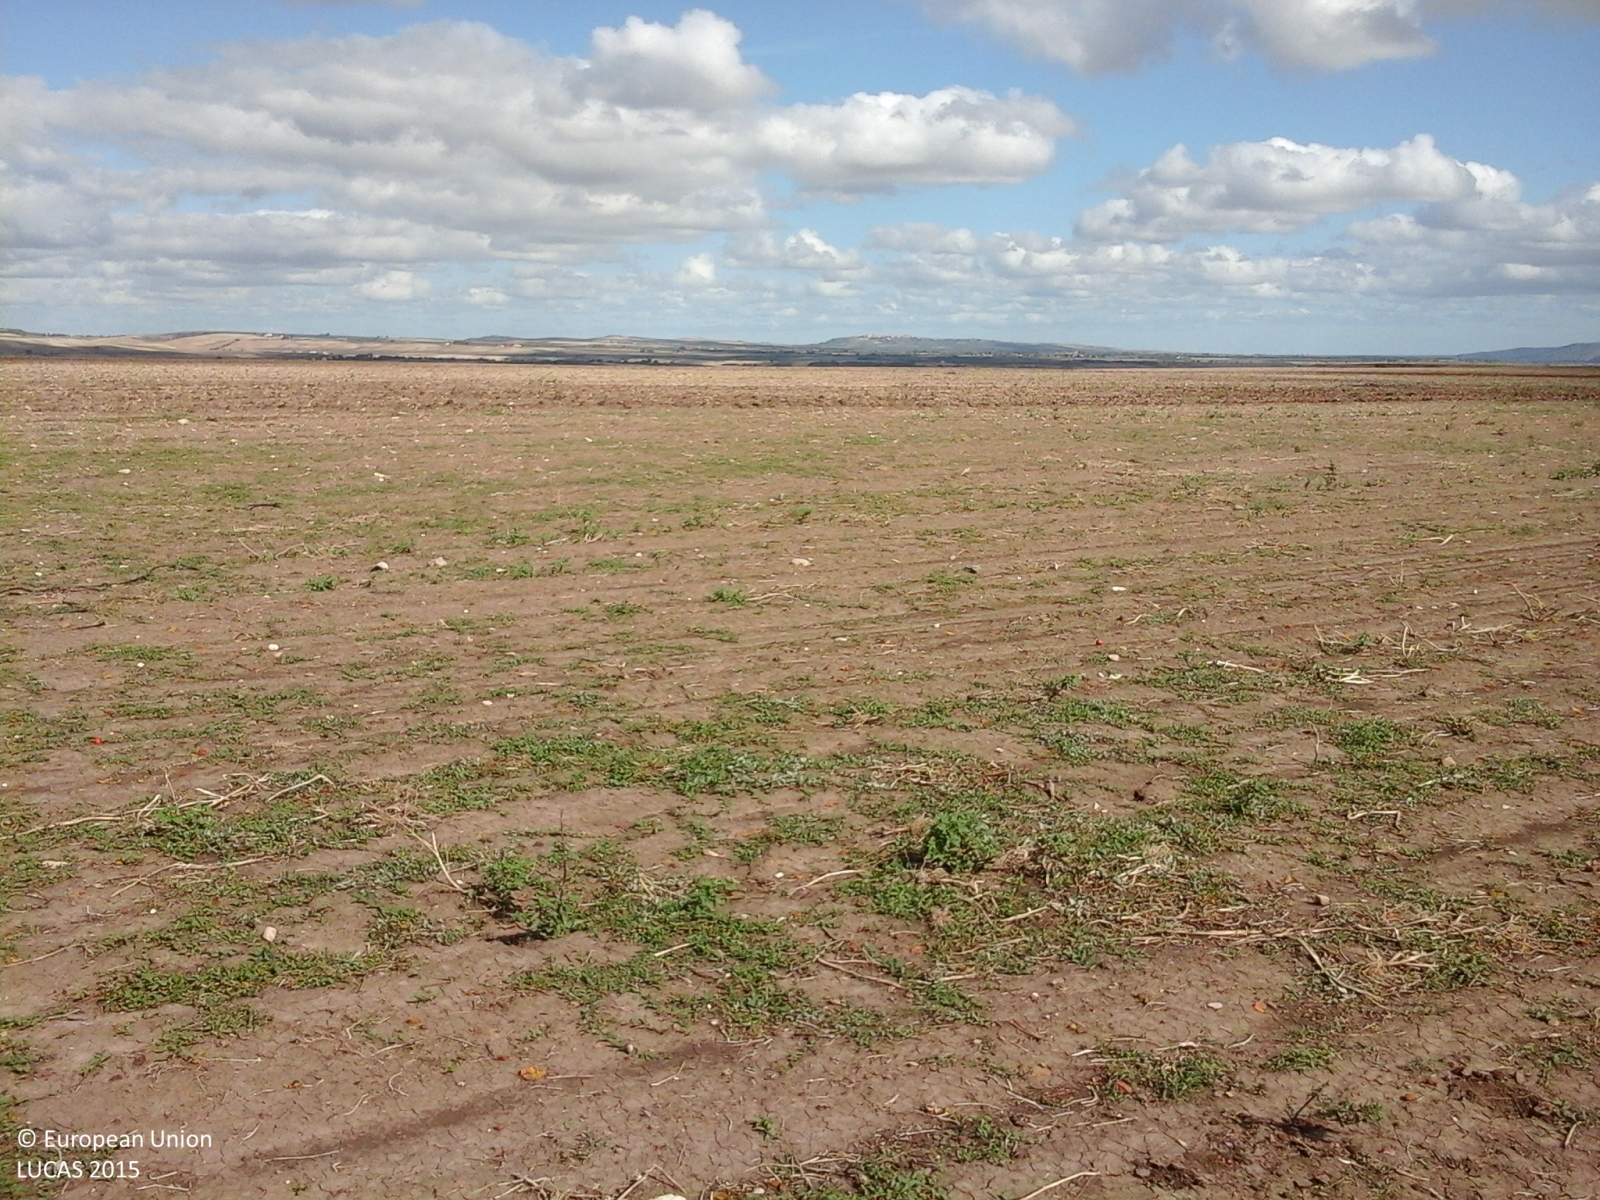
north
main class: Cropland
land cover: Tomatoes
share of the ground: < 10 %
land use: Agriculture (excluding fallow land and kitchen gardens)
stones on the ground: < 10 %
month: September
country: IT
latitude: 41.6730
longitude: 15.1363
